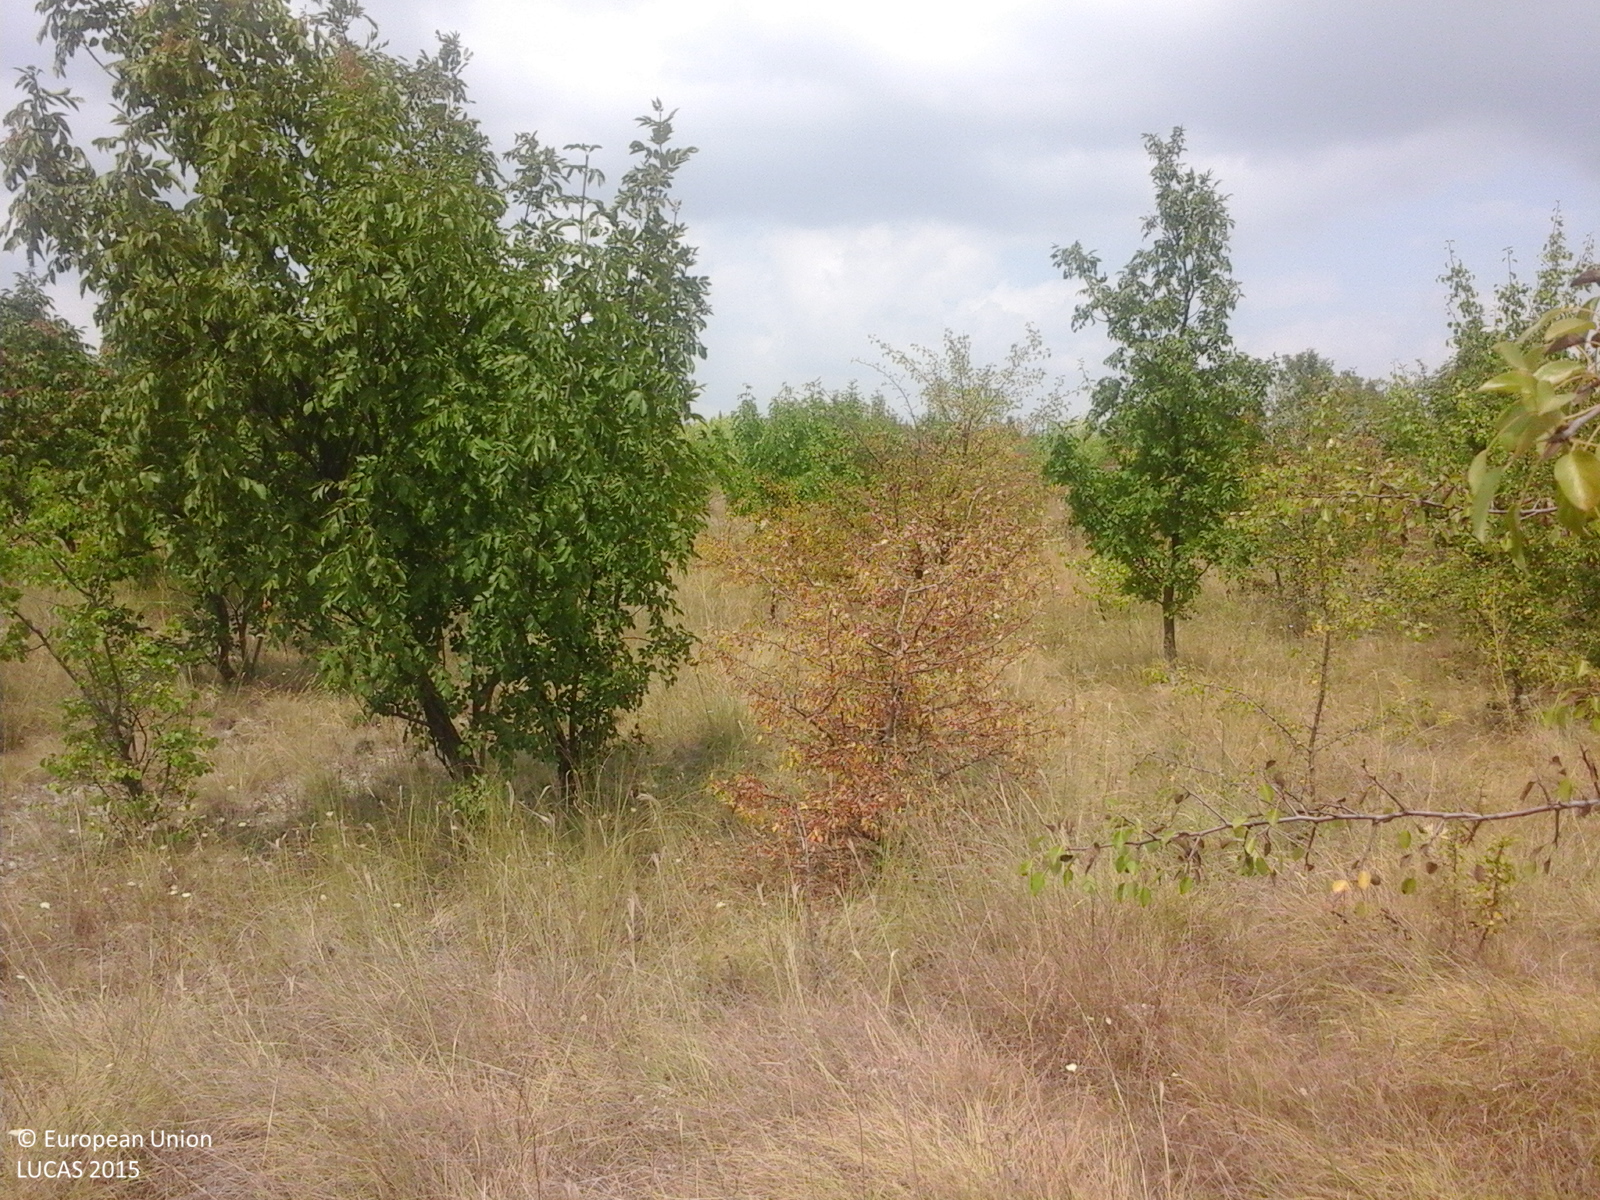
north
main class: Grassland
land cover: Grassland with sparse tree/shrub cover
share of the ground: > 75 %
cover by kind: herbaceous plants 95 %, broadleaved forest trees 5 %
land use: Fallow land
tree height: < 5 m
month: July
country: RO
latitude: 44.9033
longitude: 28.2948
